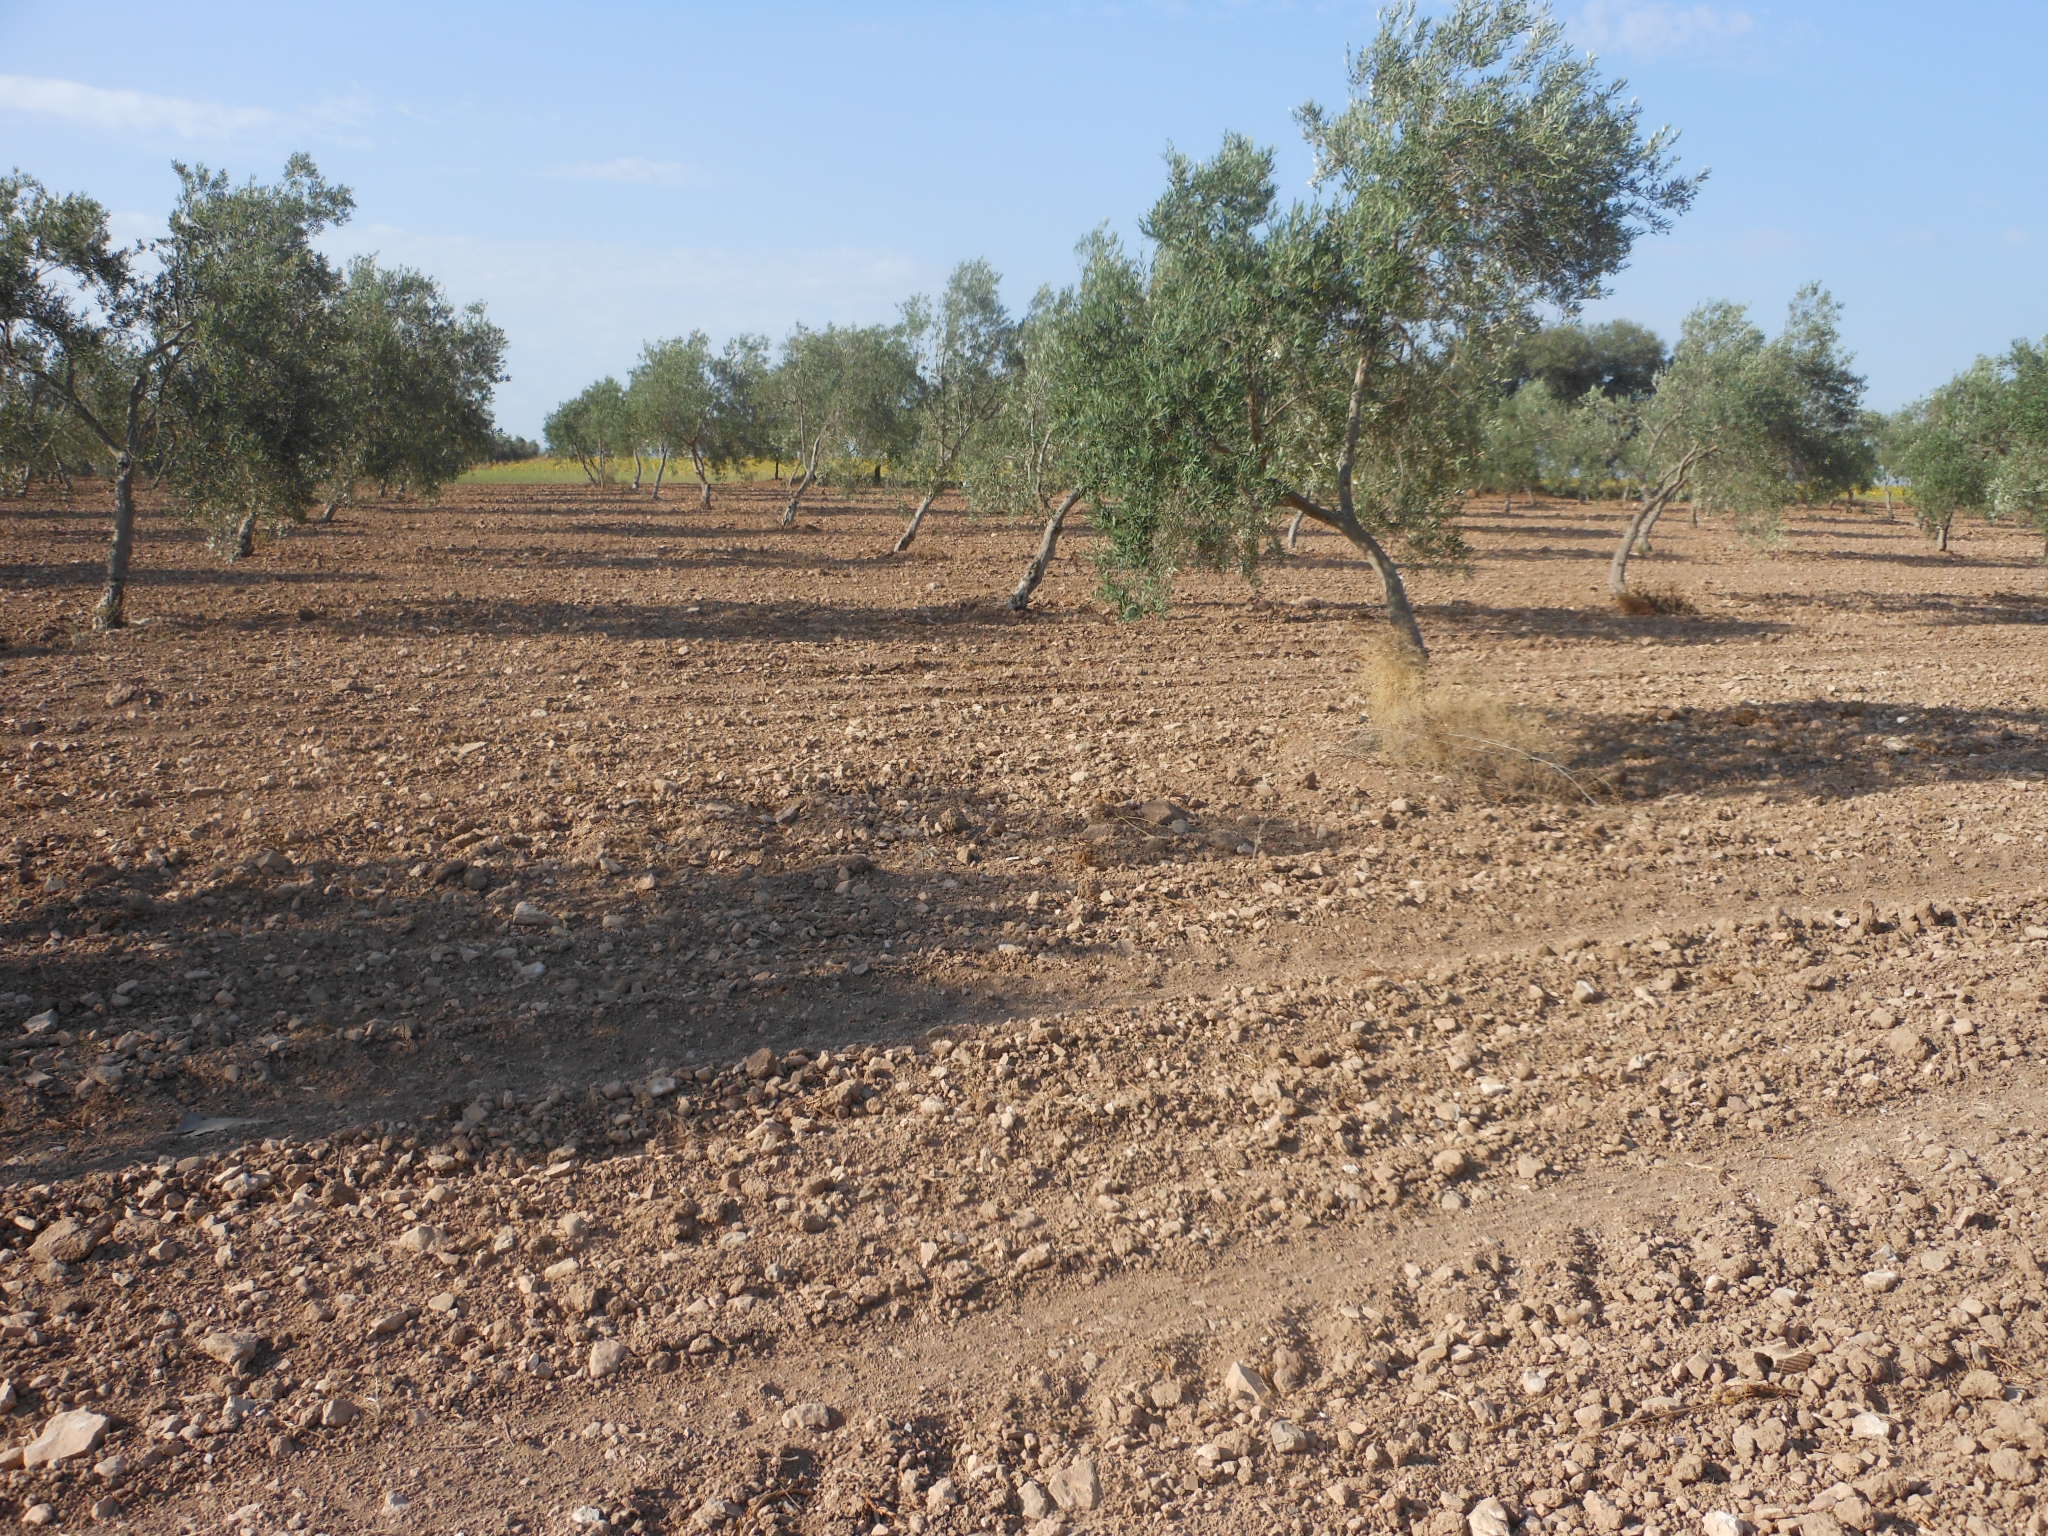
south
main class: Cropland
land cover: Olive groves
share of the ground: 10 - 25 %
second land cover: Other bare soil
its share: > 75 %
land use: Agriculture (excluding fallow land and kitchen gardens)
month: June
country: ES
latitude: 37.2871
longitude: -5.1119
